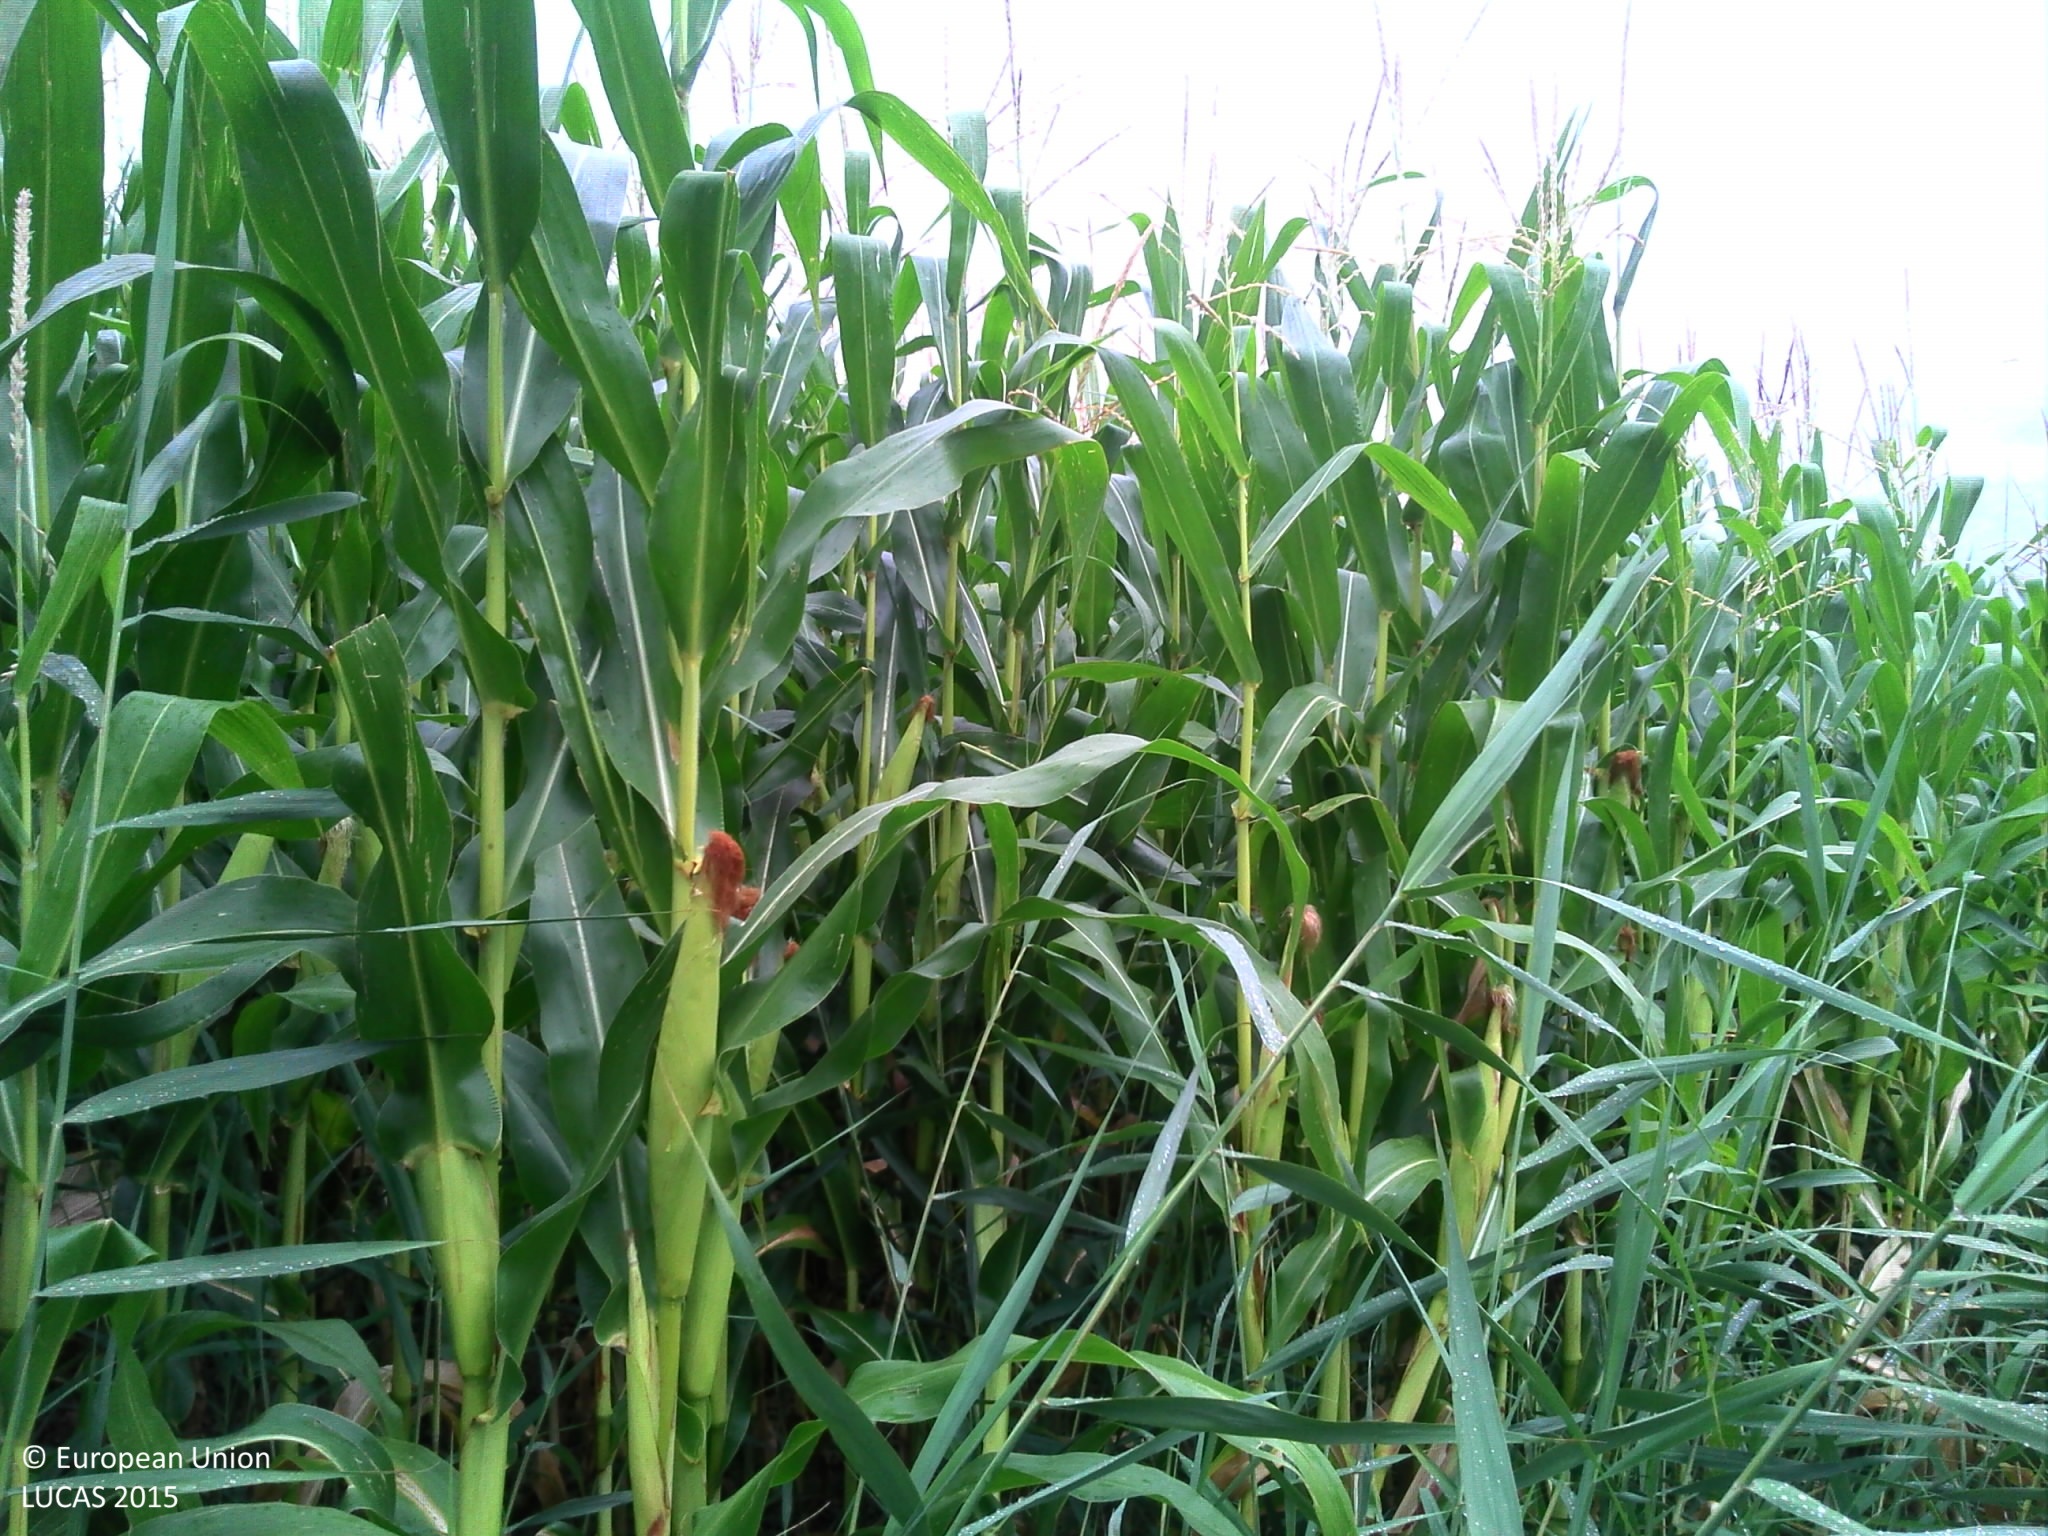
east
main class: Cropland
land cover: Maize
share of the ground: > 75 %
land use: Agriculture (excluding fallow land and kitchen gardens)
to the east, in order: Maize; Common wheat; Maize
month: August
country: FR
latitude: 48.9262
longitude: 8.0489
